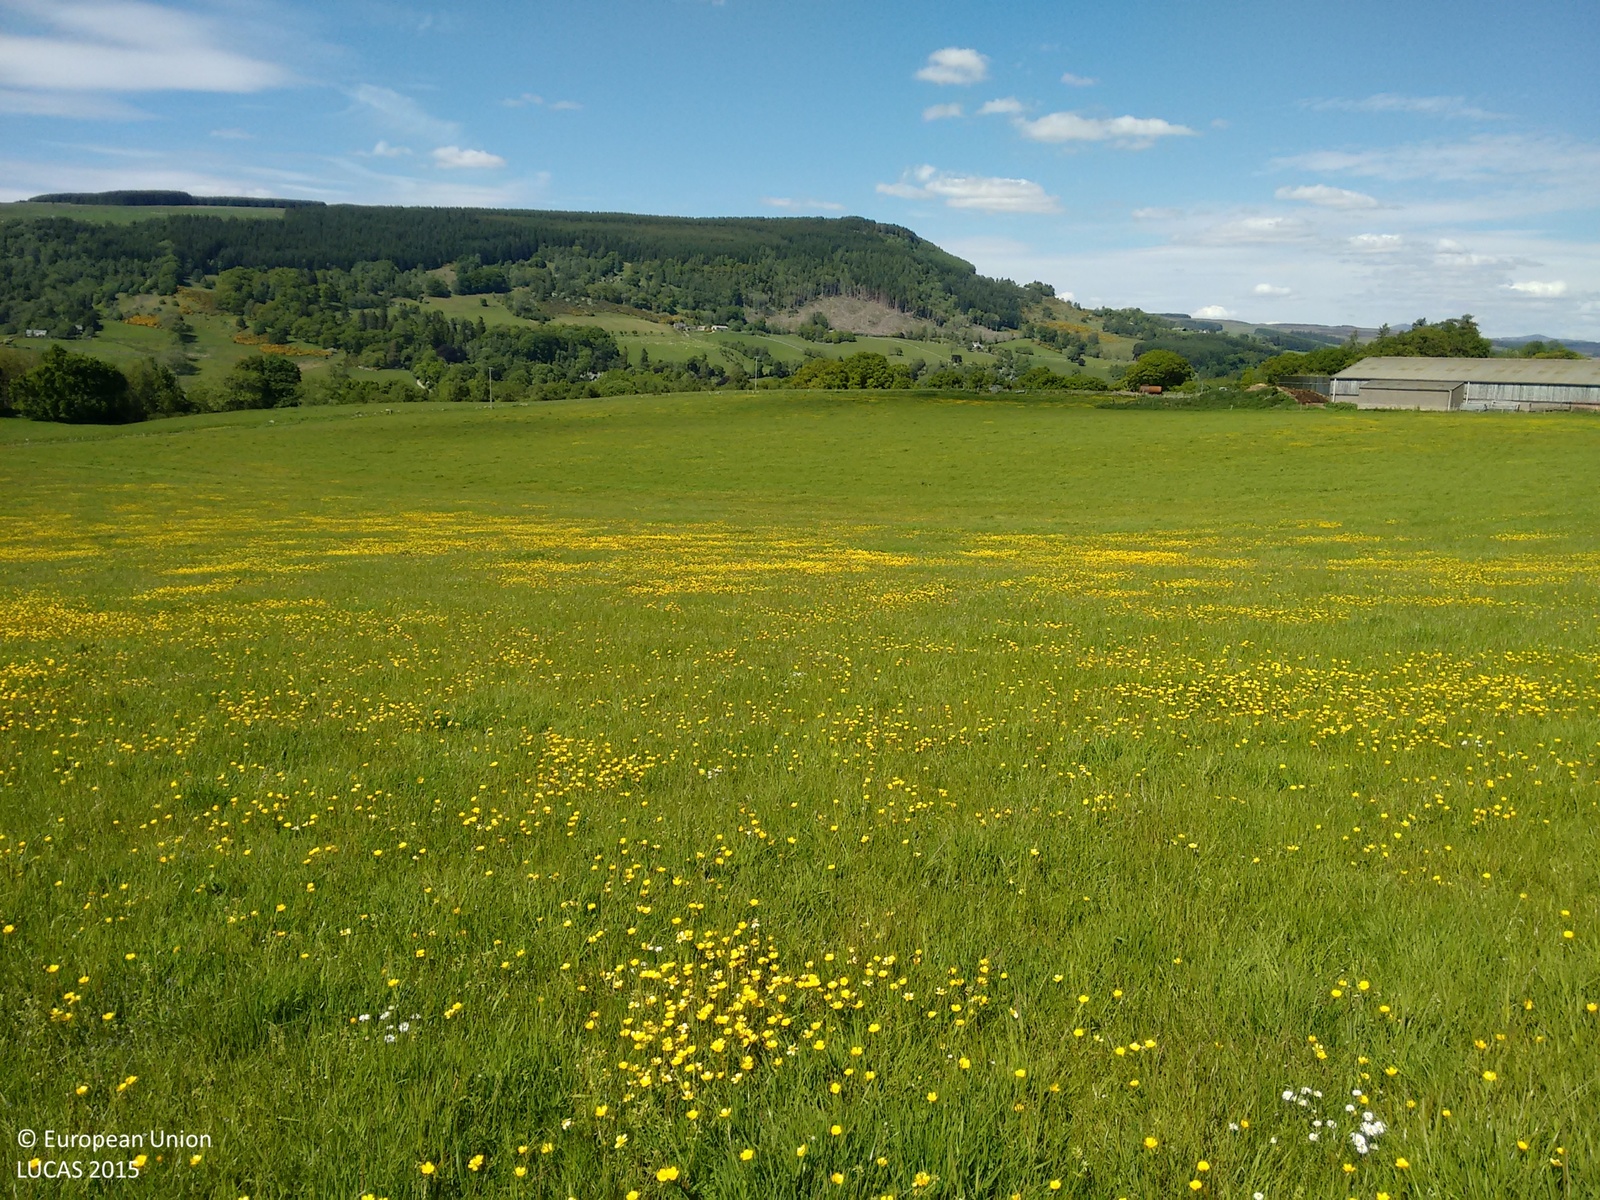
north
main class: Grassland
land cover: Grassland without tree/shrub cover
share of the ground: > 75 %
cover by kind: herbaceous plants 100 %
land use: Agriculture (excluding fallow land and kitchen gardens)
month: June
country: GB
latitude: 56.6195
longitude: -3.8522
